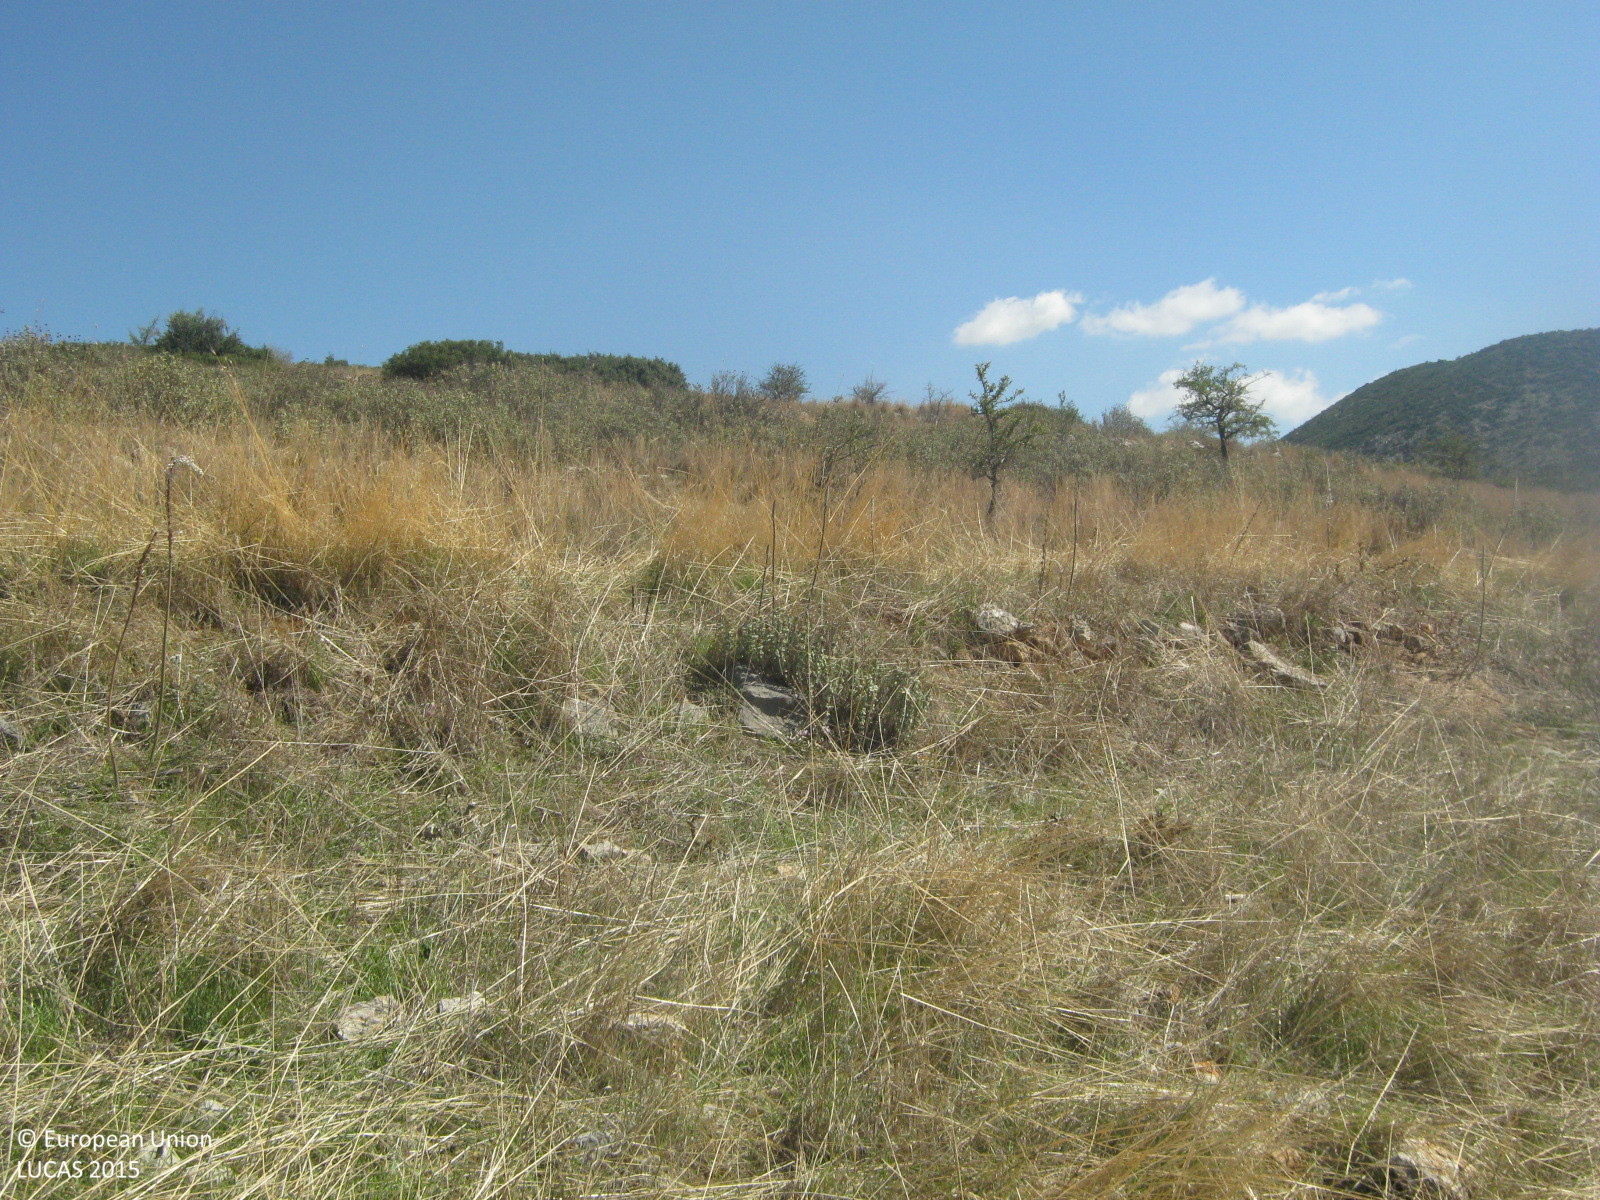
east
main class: Grassland
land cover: Grassland with sparse tree/shrub cover
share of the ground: 50 - 75 %
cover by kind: herbaceous plants 70 %, consolidated bare surface 15 %, shrubs 10 %, broadleaved forest trees 5 %
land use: Semi-natural and natural areas not in use
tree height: < 5 m
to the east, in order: Grassland with sparse tree/shrub cover; Shrubland without tree cover; Grassland with sparse tree/shrub cover; Dry stone walls; Spontaneously vegetated surfaces
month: October
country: GR
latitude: 37.7161
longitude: 22.8440
